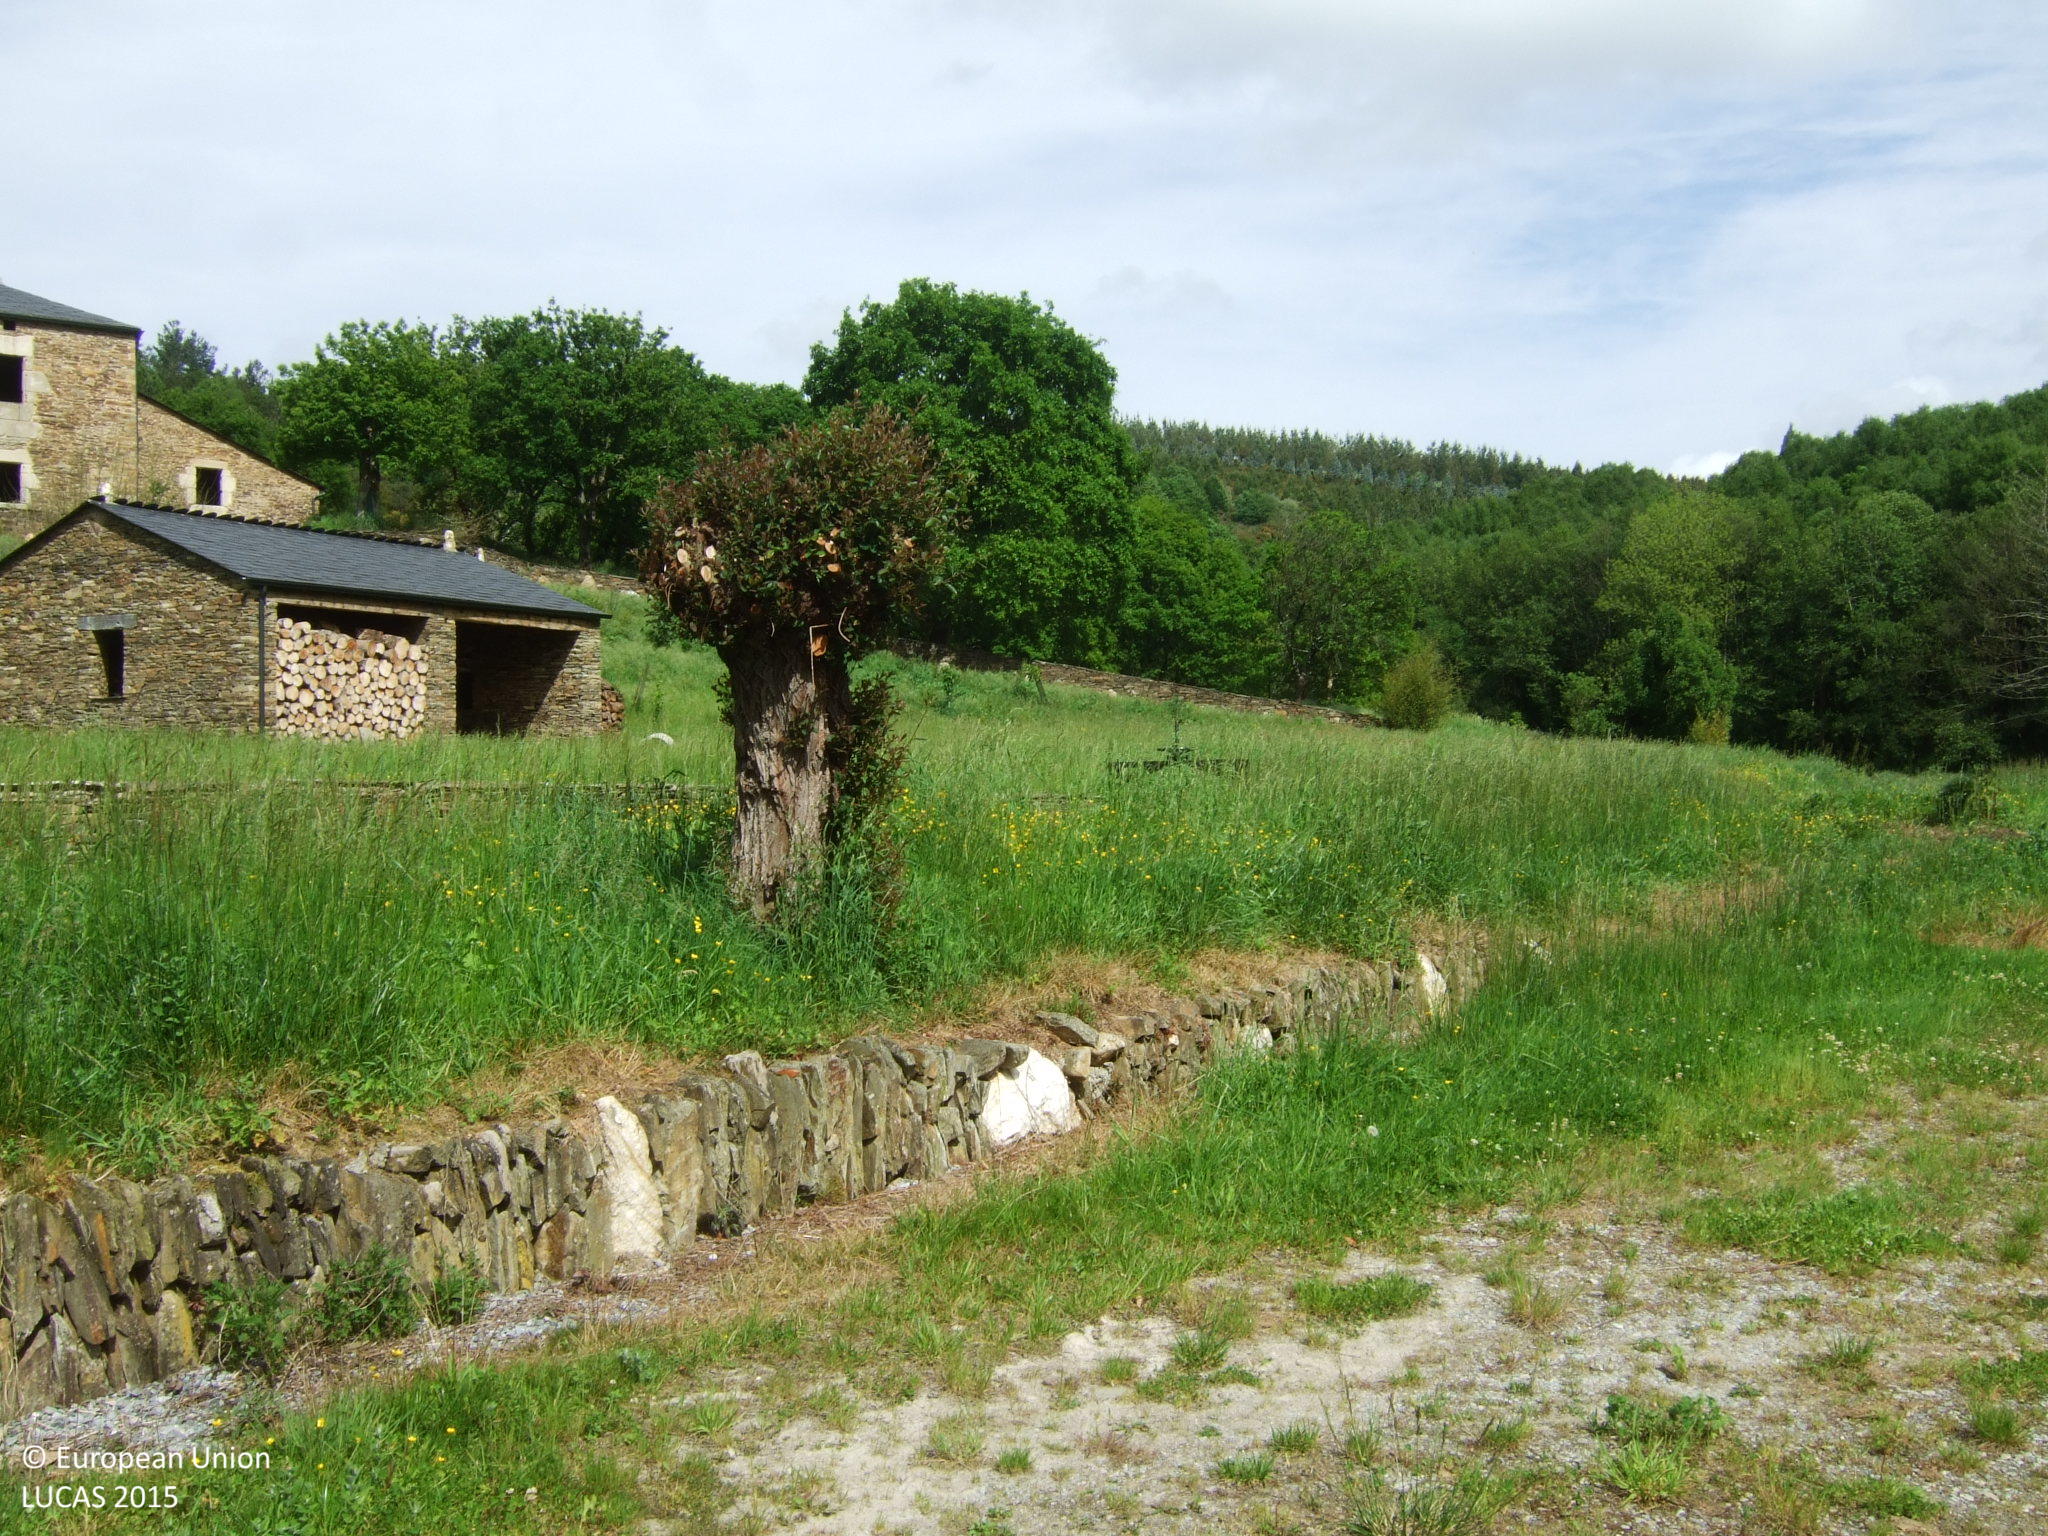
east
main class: Woodland
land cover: Broadleaved woodland
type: acidophilous oak and oak-birch forest
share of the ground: 50 - 75 %
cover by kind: broadleaved forest trees 70 %, unconsolidated bare surface 20 %, shrubs 10 %
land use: Forestry
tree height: > 5 m
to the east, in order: Broadleaved woodland; Shrubland with sparse tree cover; Broadleaved woodland; Grassland without tree/shrub cover; Broadleaved woodland
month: May
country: ES
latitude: 43.1823
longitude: -7.3851
